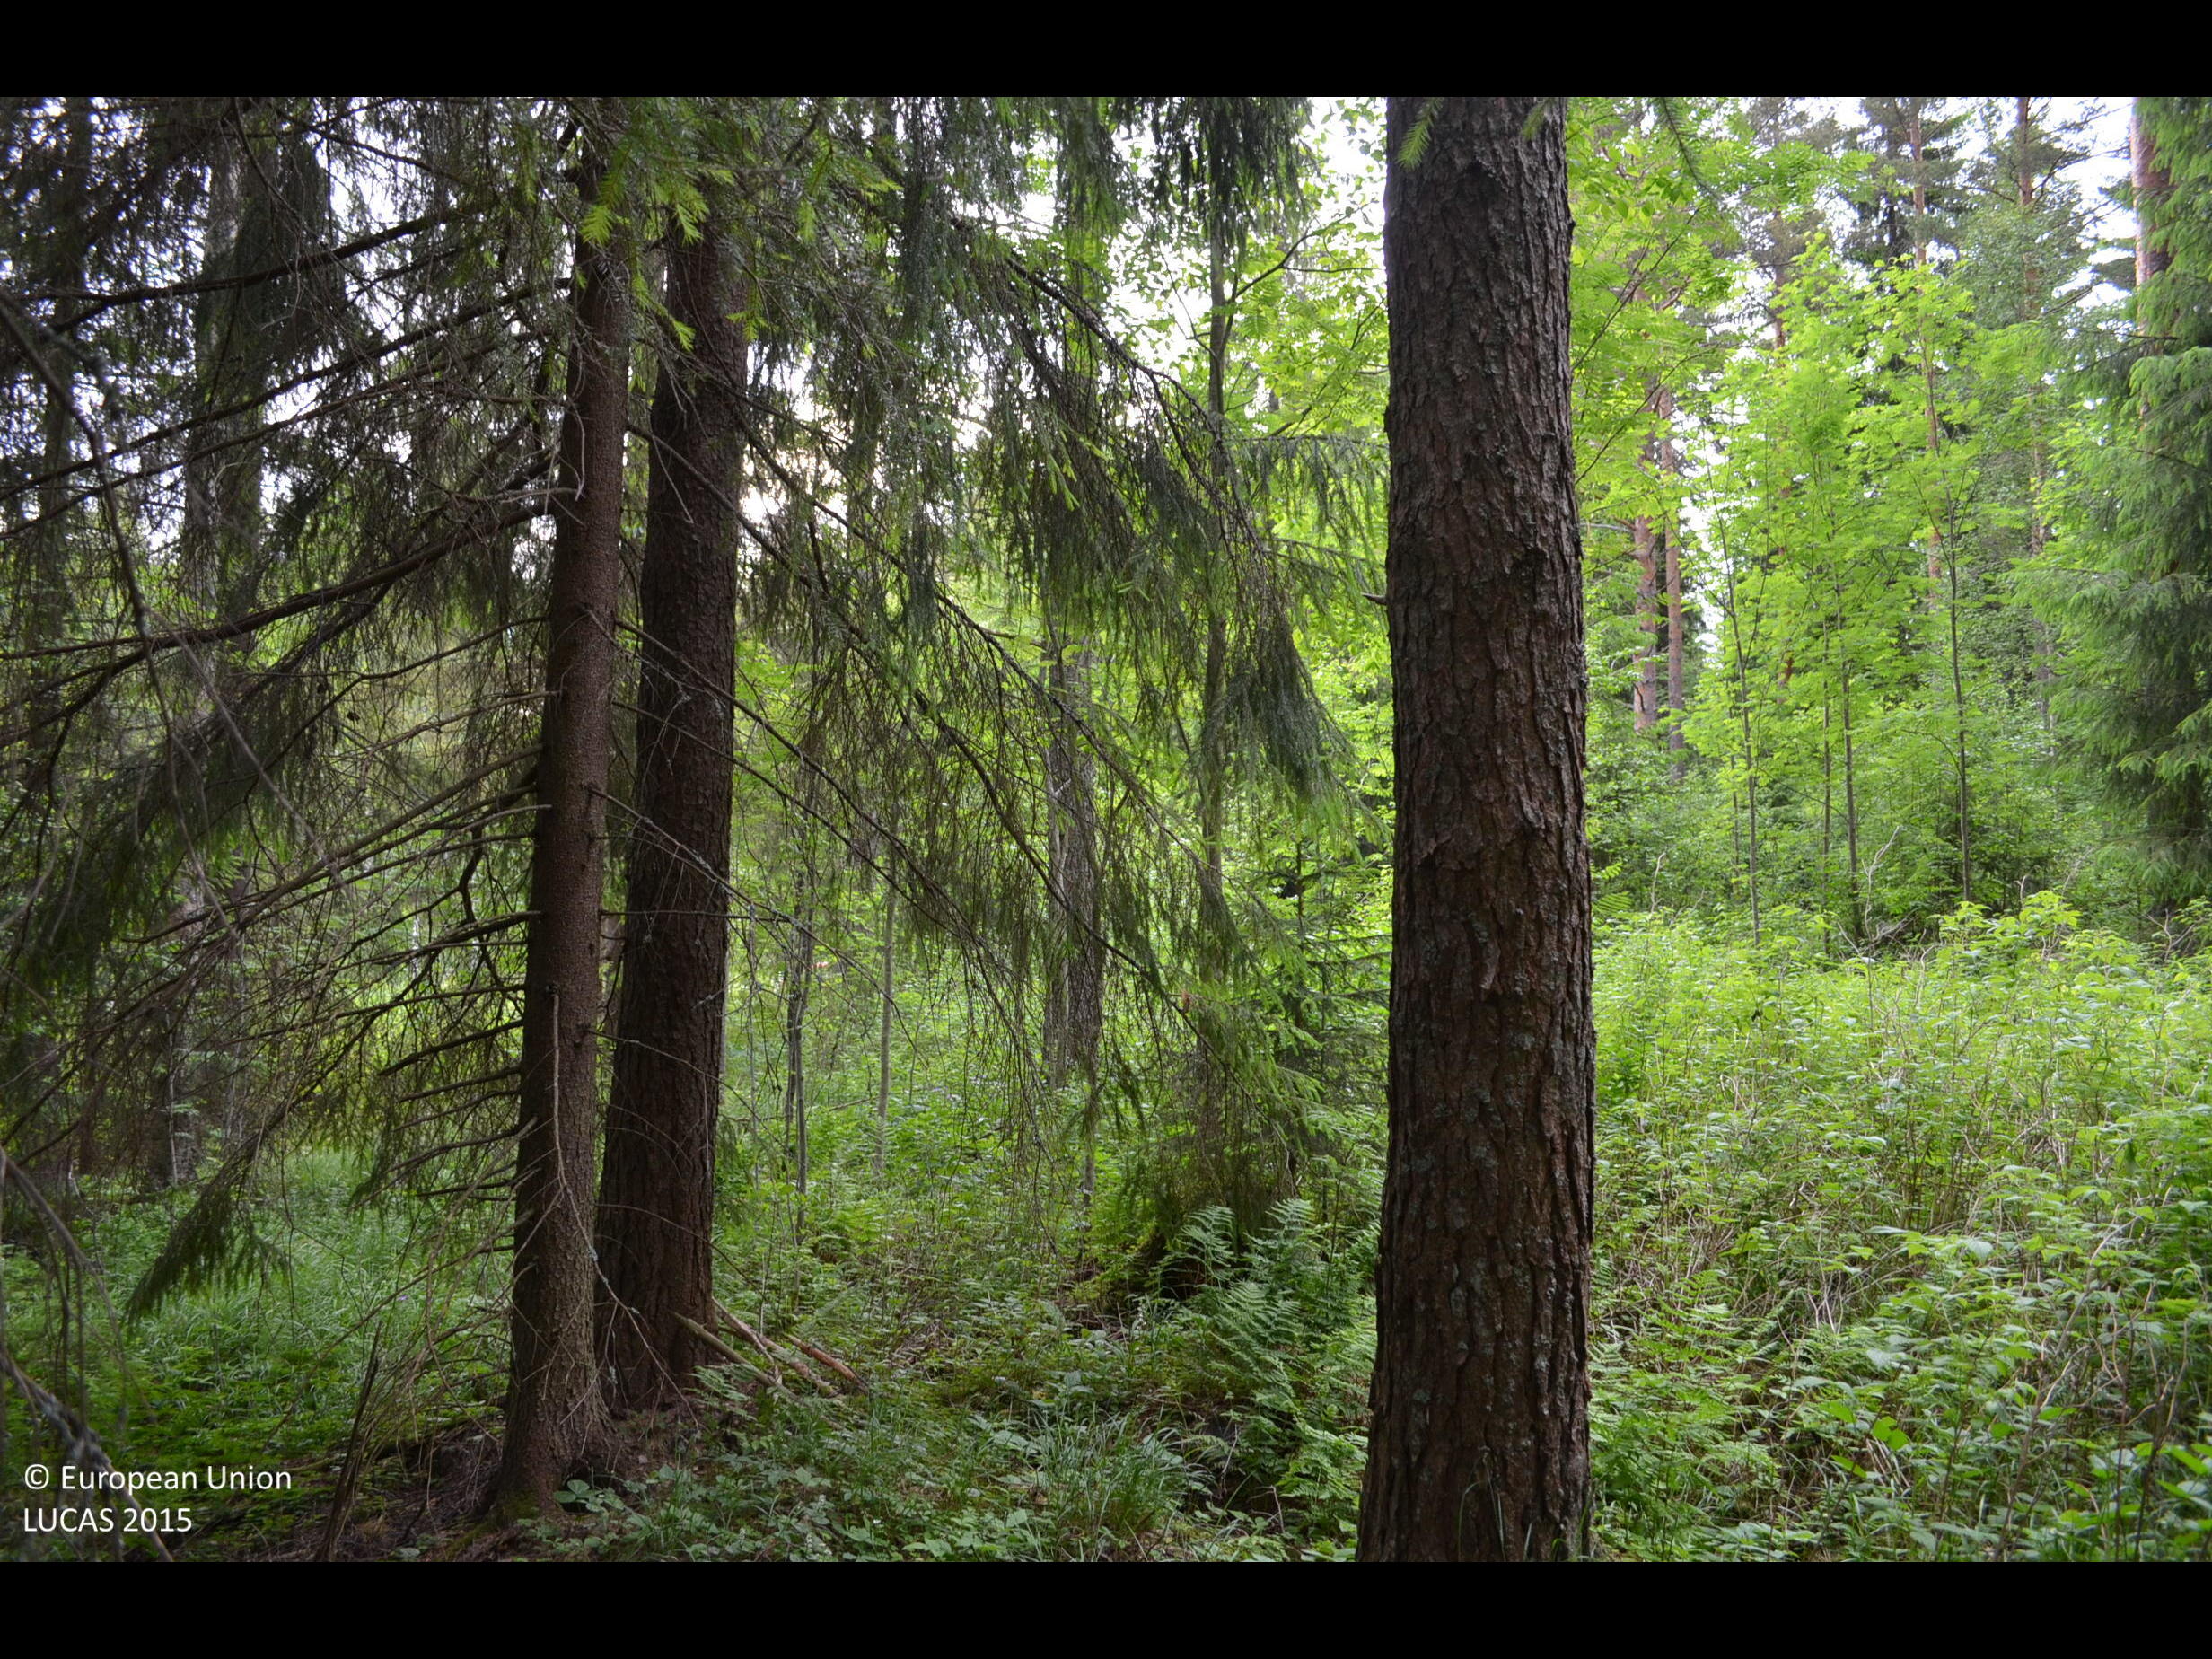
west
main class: Woodland
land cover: Other mixed woodland
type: boreal forest
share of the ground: > 75 %
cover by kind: coniferous forest trees 50 %, broadleaved forest trees 35 %, shrubs 10 %, herbaceous plants 5 %
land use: Forestry
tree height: > 5 m
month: June
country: FI
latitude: 61.8103
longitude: 23.3769
